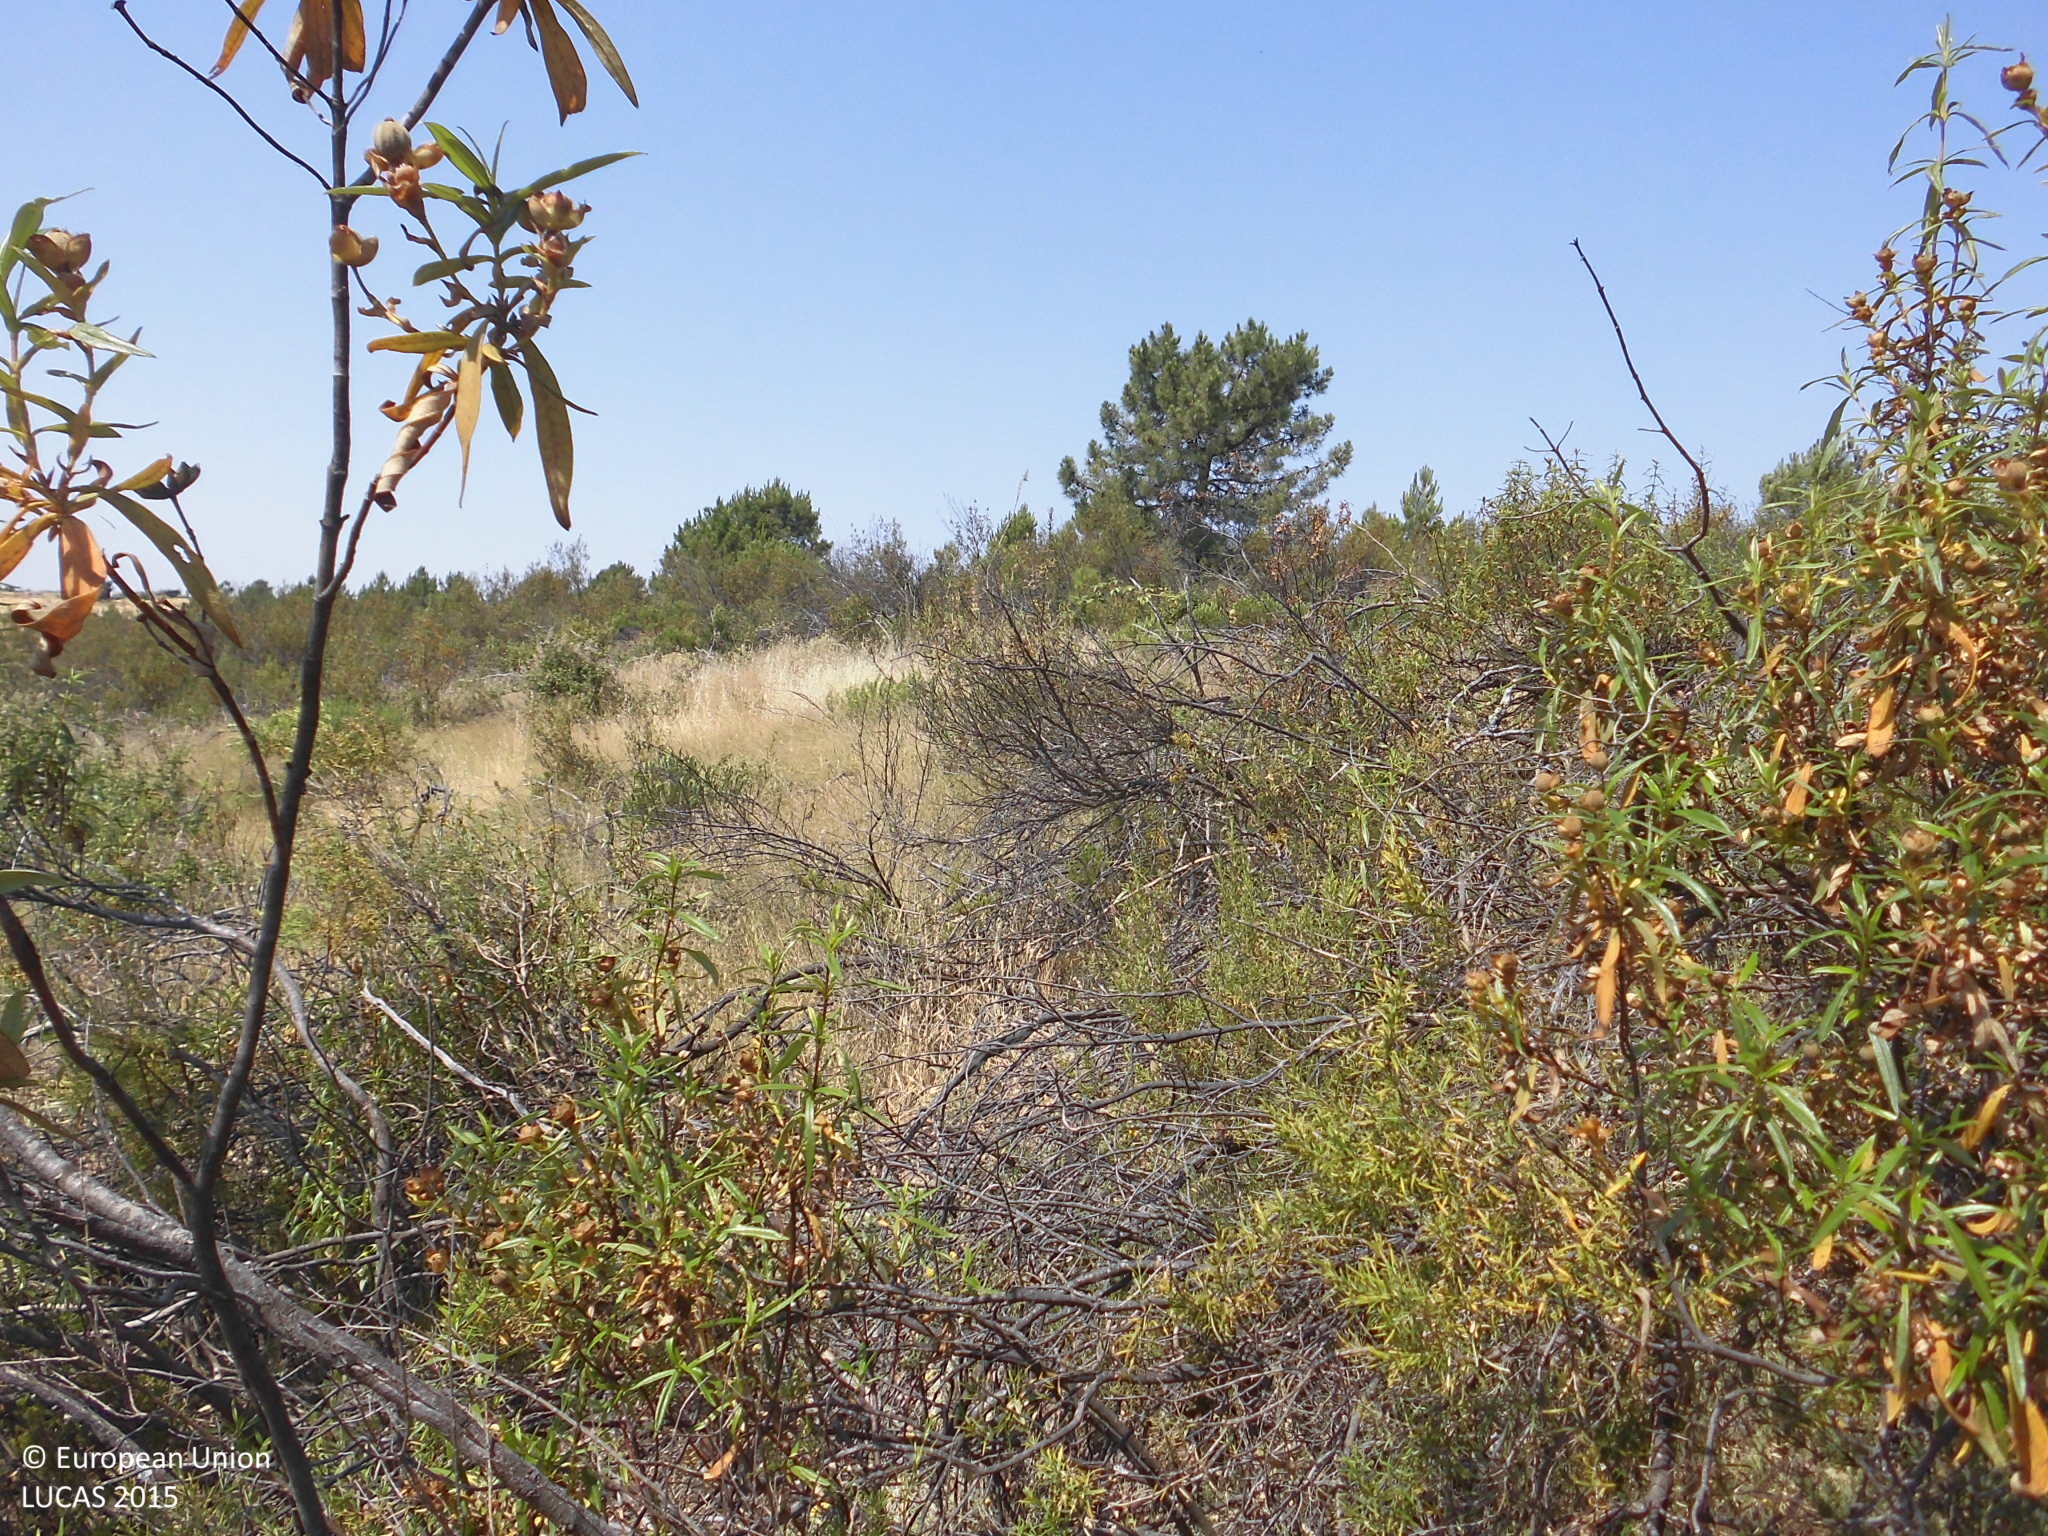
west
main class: Shrubland
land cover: Shrubland without tree cover
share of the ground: > 75 %
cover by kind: shrubs 90 %, herbaceous plants 10 %
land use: Abandoned areas
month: June
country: ES
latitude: 40.0956
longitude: -5.4855
